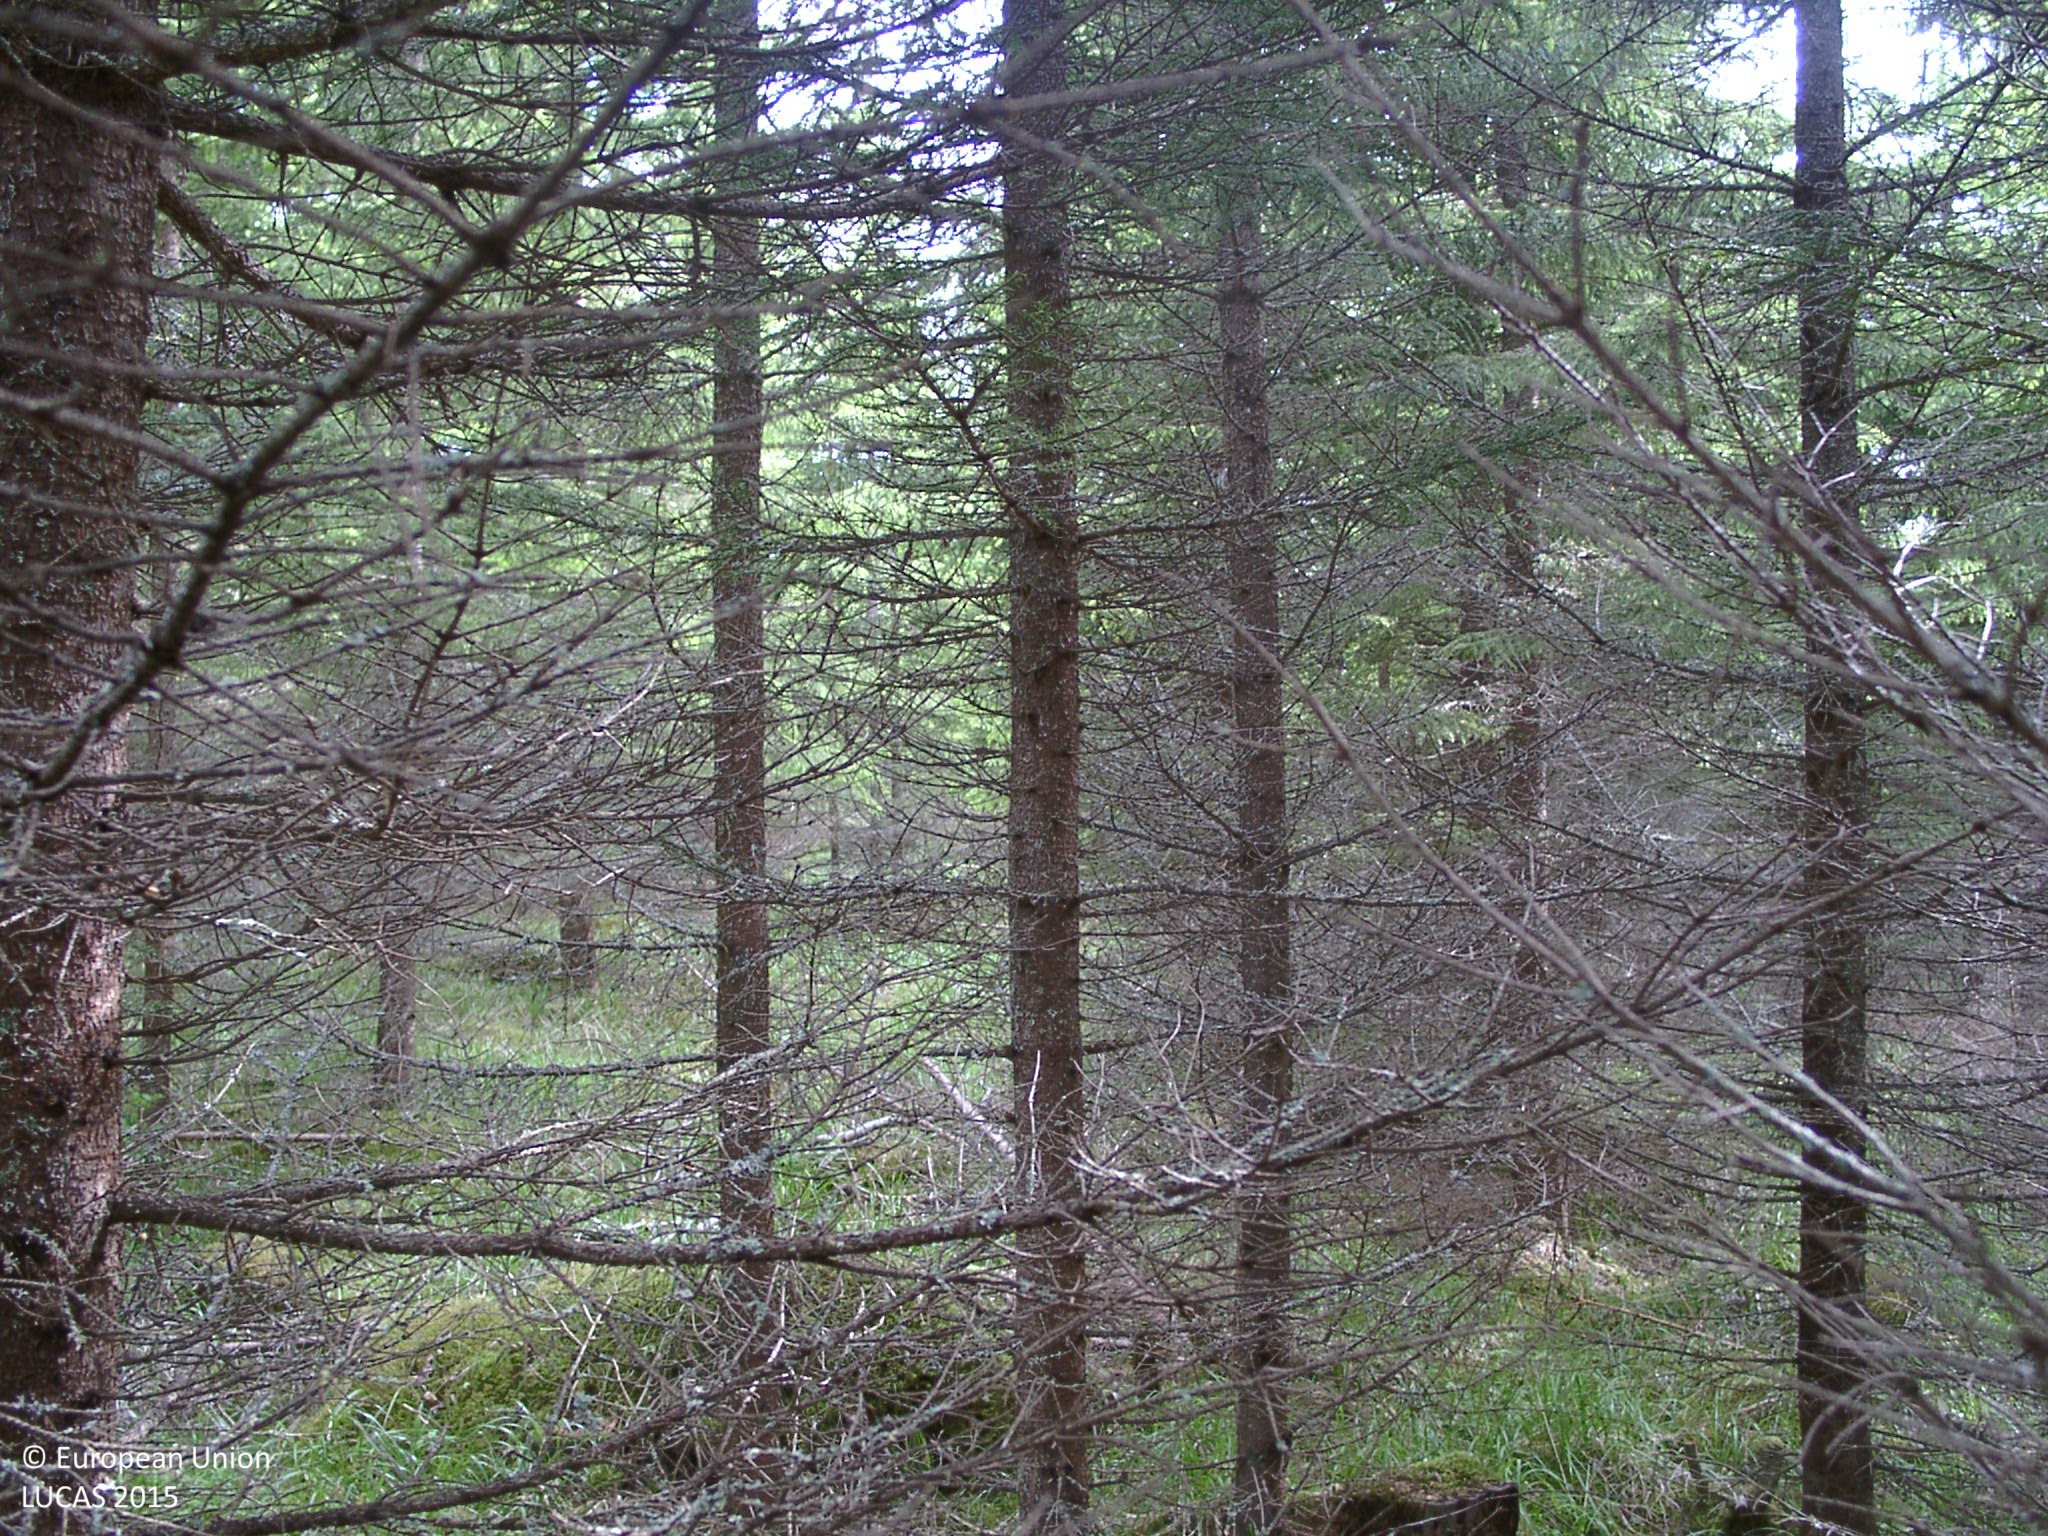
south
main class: Woodland
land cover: Spruce dominated coniferous woodland
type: boreal forest
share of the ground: 50 - 75 %
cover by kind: coniferous forest trees 70 %, herbaceous plants 20 %, lichens and mosses 10 %
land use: Forestry
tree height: > 5 m
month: June
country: FI
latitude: 61.7722
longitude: 24.9068
